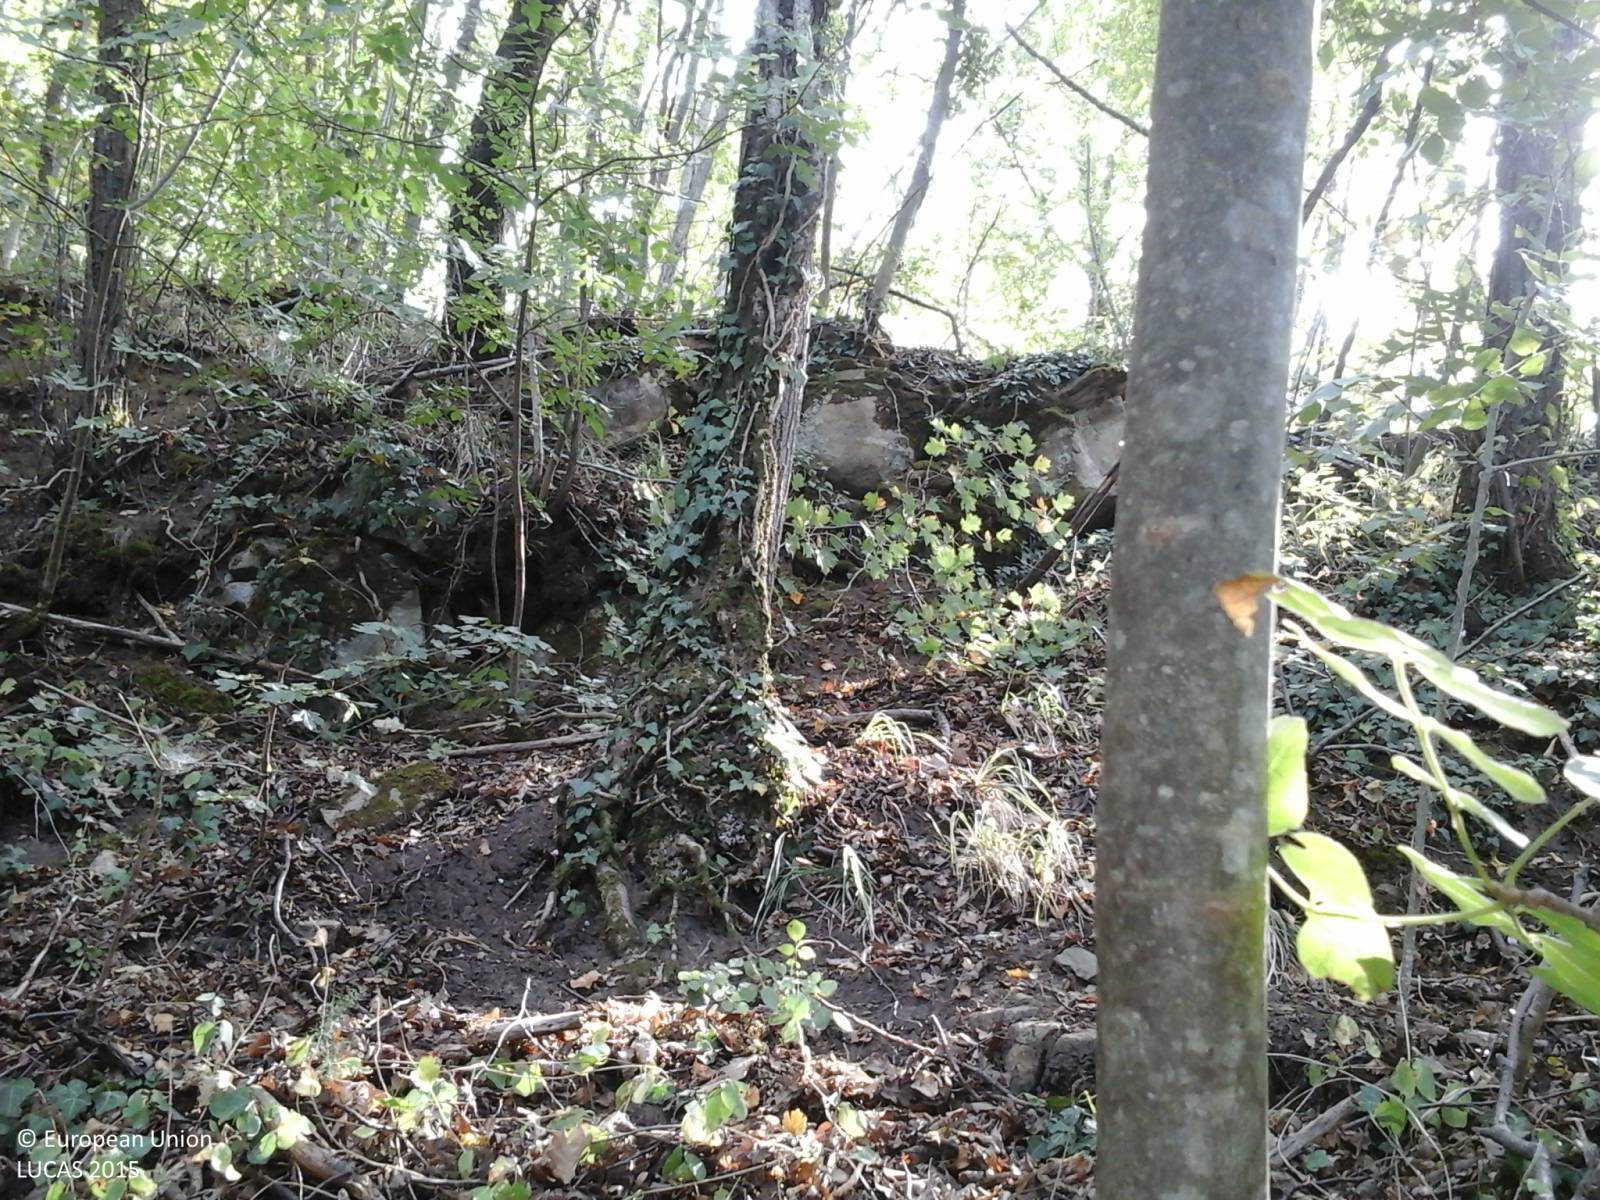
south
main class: Woodland
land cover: Broadleaved woodland
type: thermophilous deciduous forest
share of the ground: > 75 %
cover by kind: broadleaved forest trees 95 %, shrubs 5 %
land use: Forestry
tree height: > 5 m
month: September
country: IT
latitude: 43.1449
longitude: 12.5870
